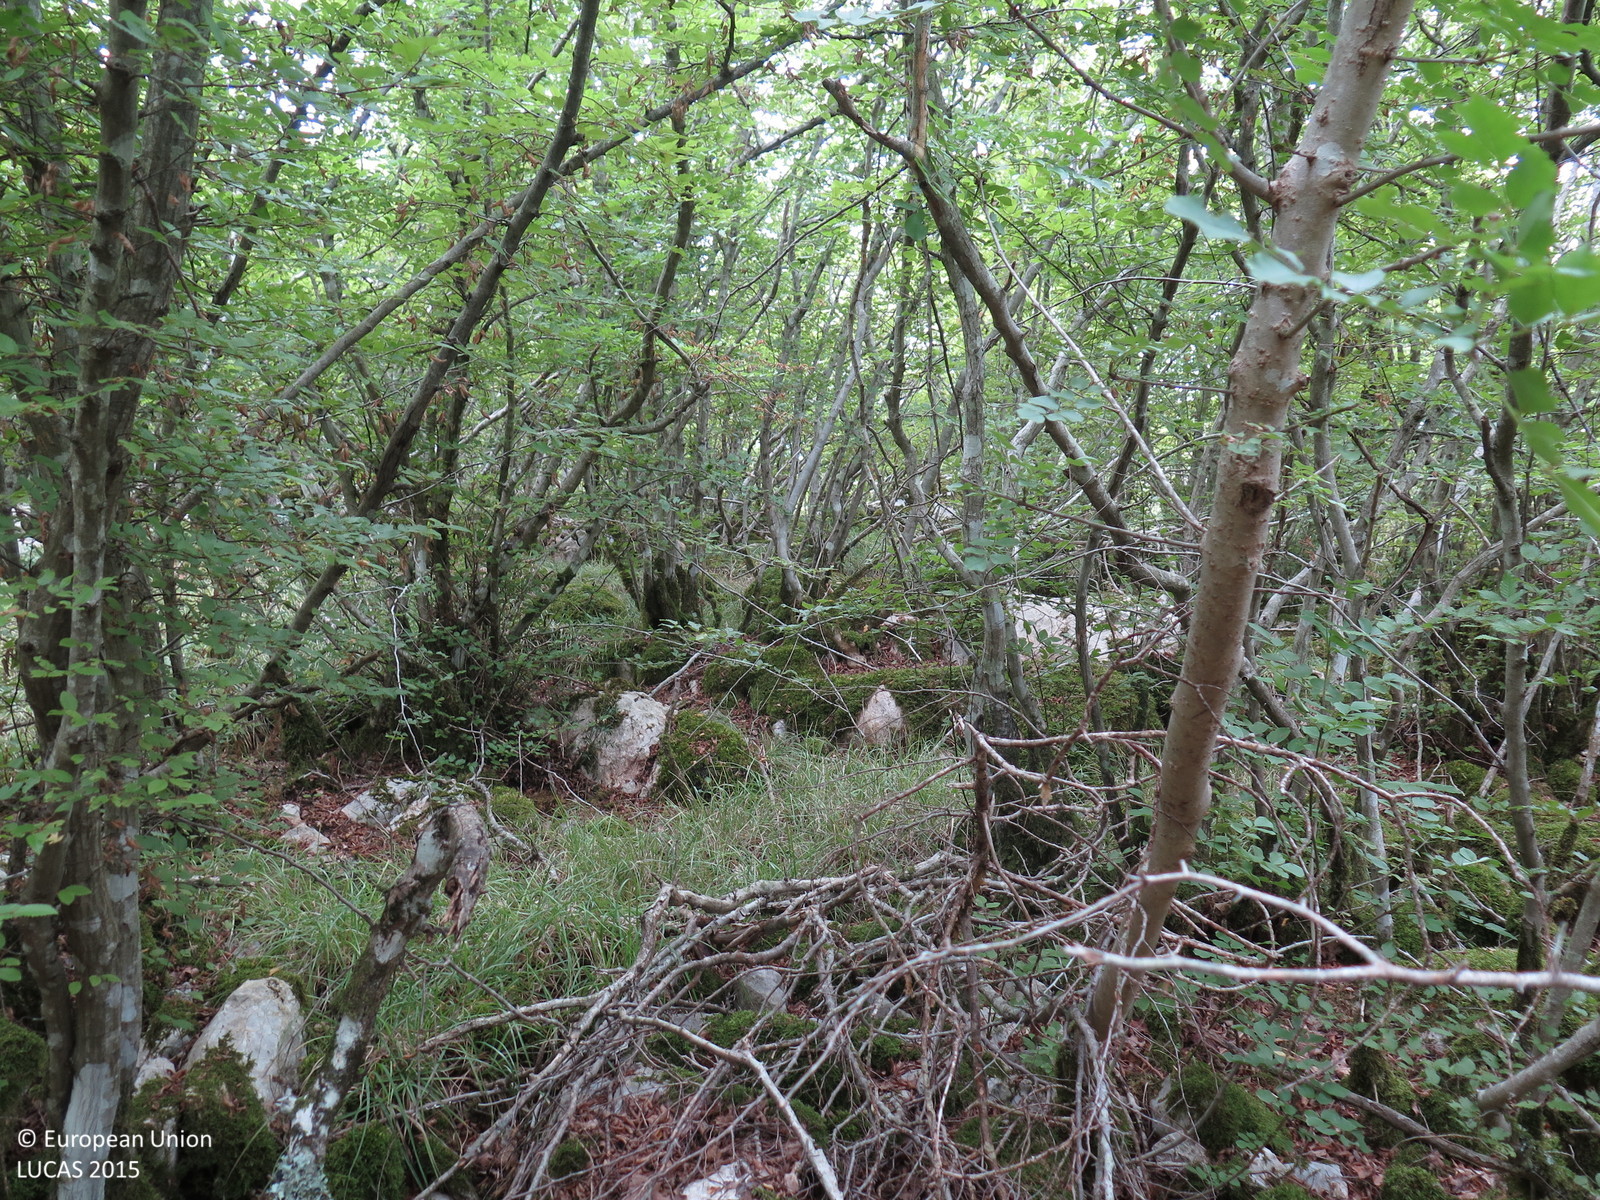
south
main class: Woodland
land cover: Broadleaved woodland
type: thermophilous deciduous forest
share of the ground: > 75 %
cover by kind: broadleaved forest trees 90 %, lichens and mosses 5 %, unconsolidated bare surface 5 %
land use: Semi-natural and natural areas not in use
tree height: < 5 m
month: August
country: HR
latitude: 45.1161
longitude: 14.5834
